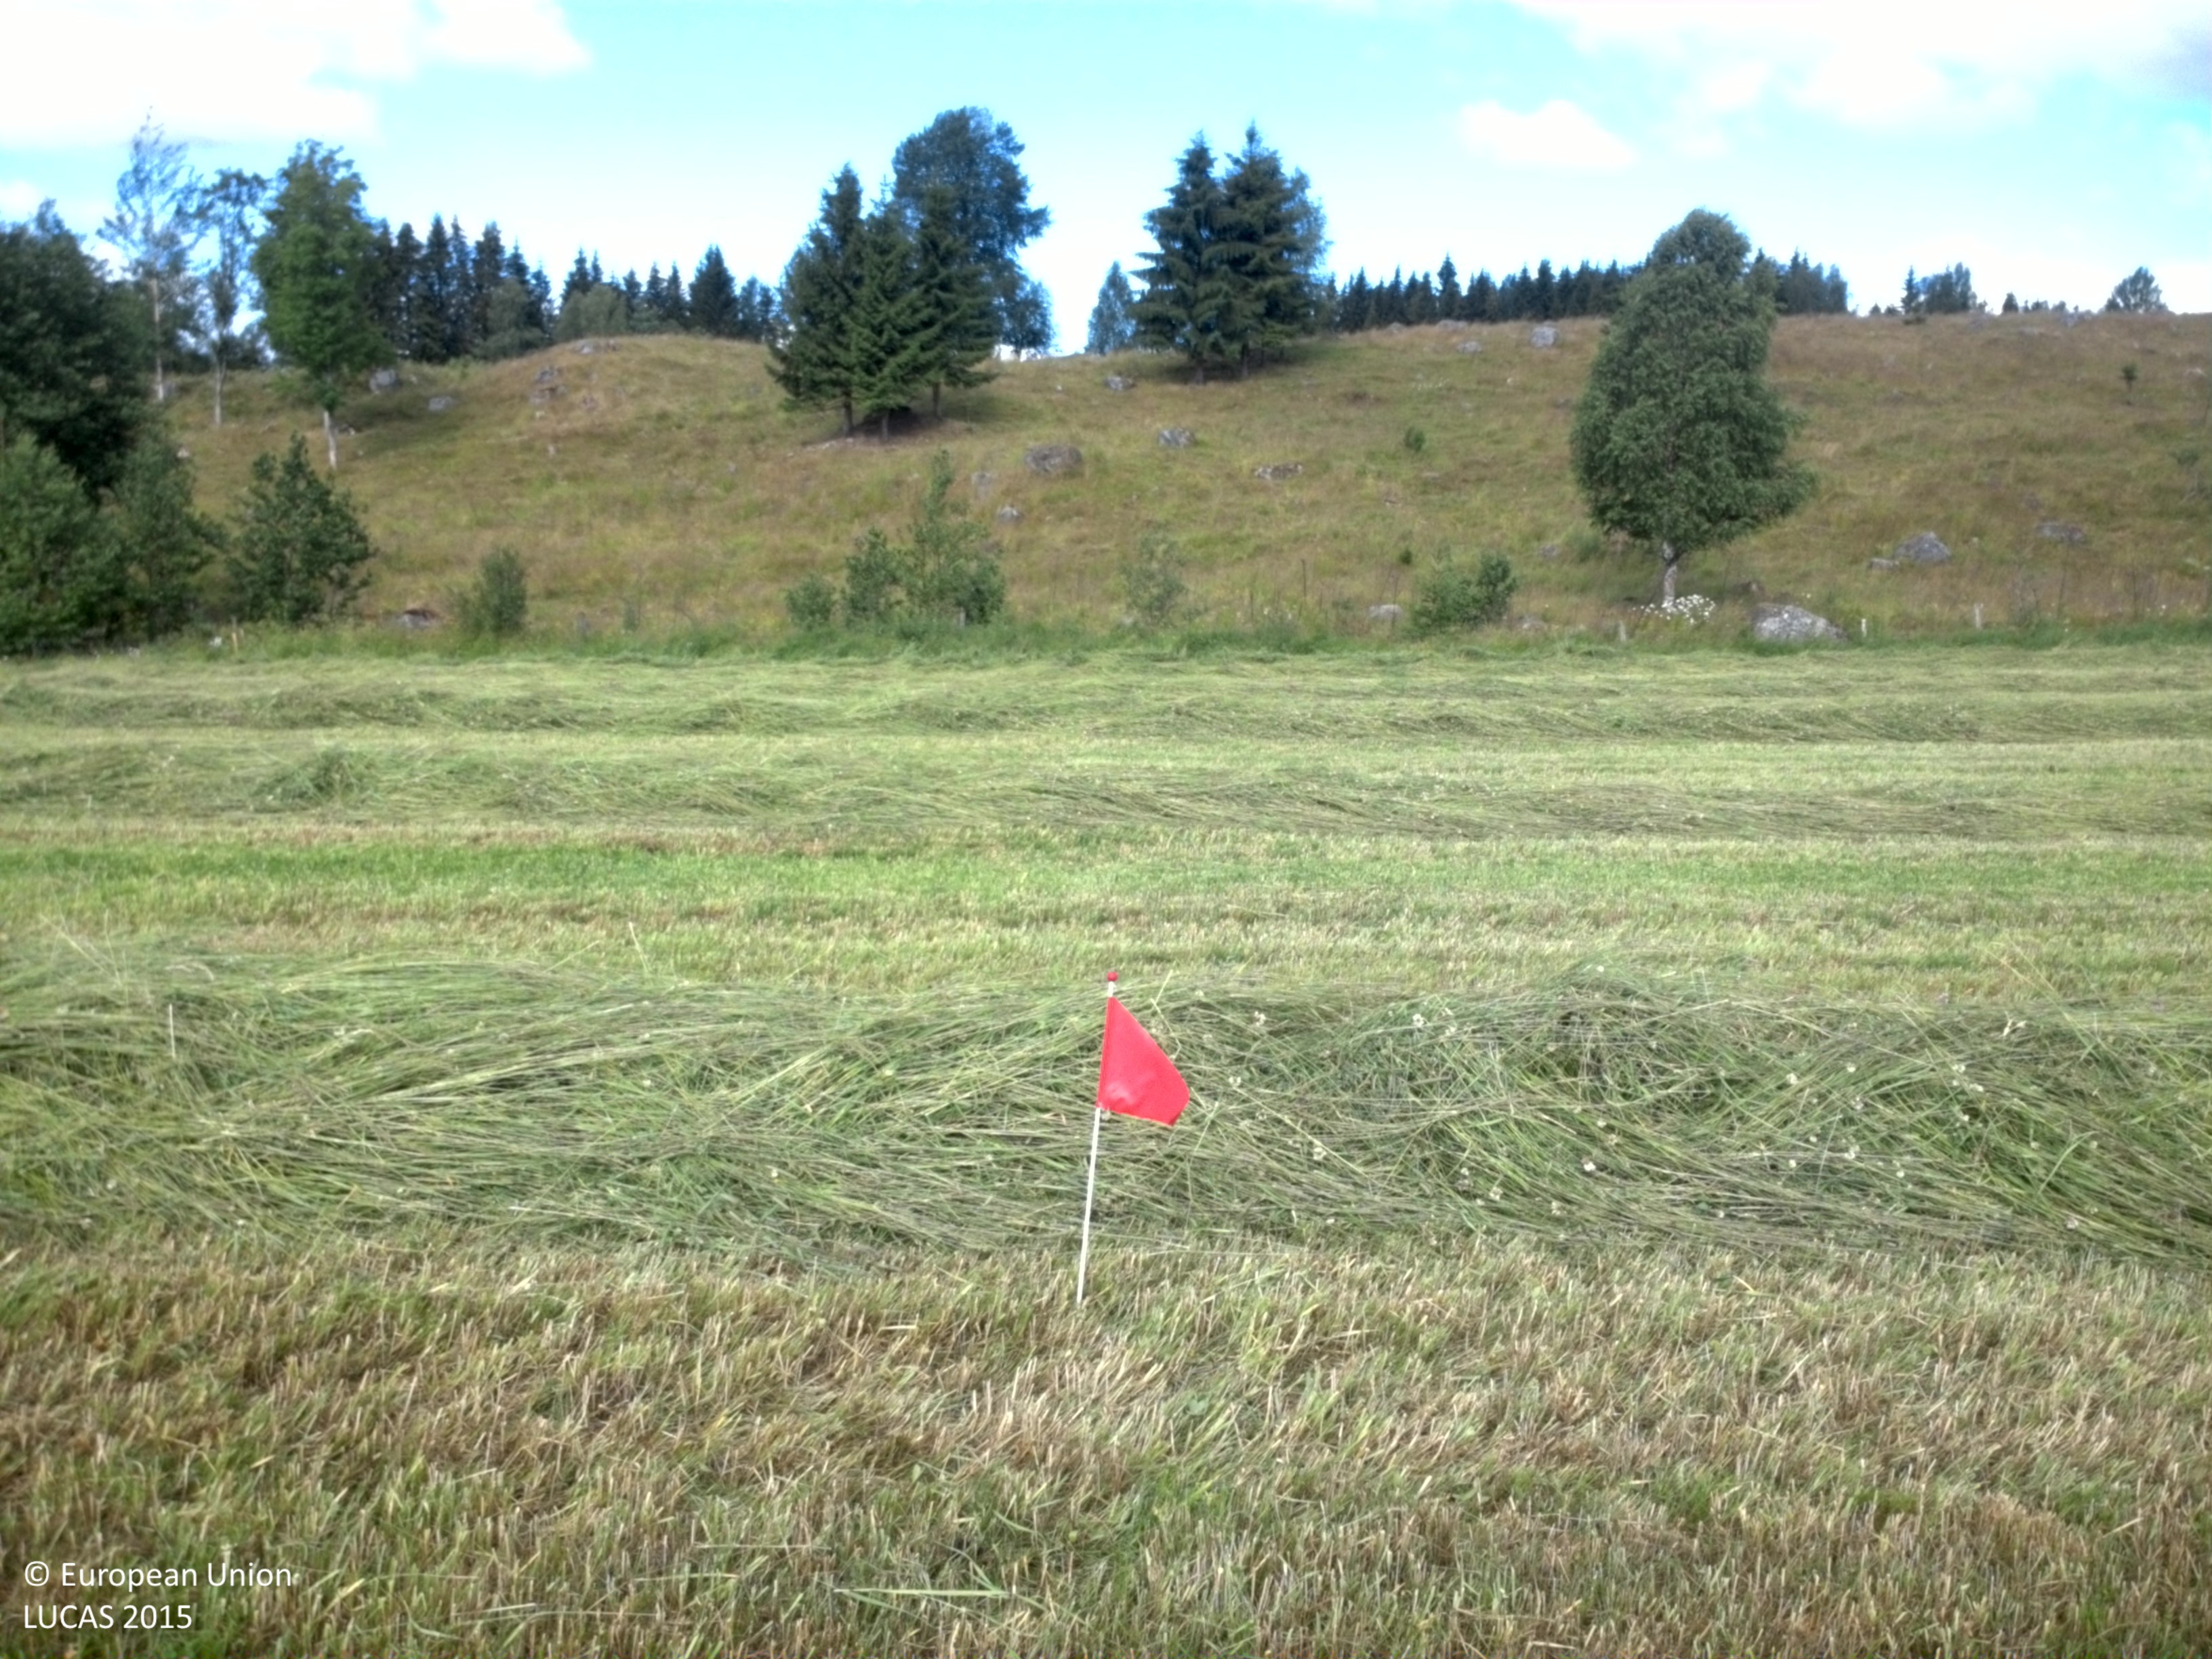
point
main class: Cropland
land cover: Other leguminous and mixtures for fodder
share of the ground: > 75 %
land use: Agriculture (excluding fallow land and kitchen gardens)
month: July
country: SE
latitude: 59.8534
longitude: 12.4389
